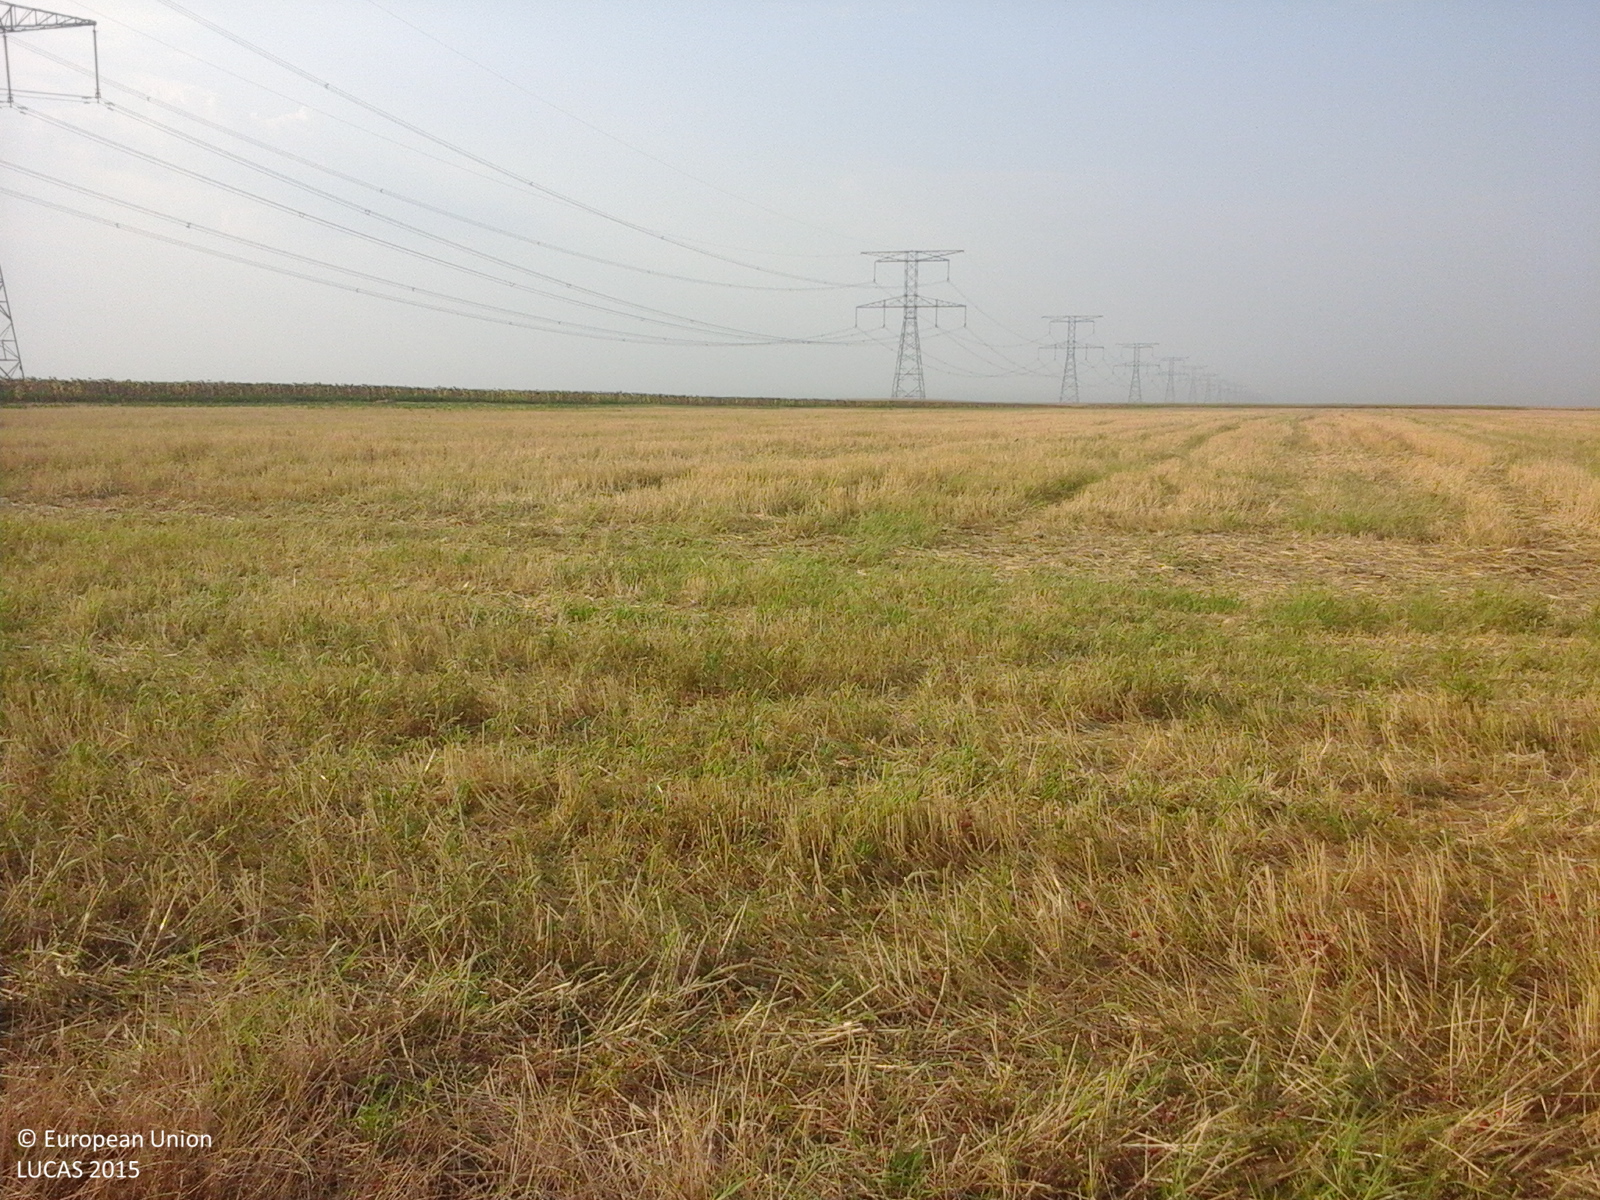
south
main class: Cropland
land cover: Sunflower
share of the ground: > 75 %
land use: Agriculture (excluding fallow land and kitchen gardens)
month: August
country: RO
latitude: 44.0089
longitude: 23.6595
